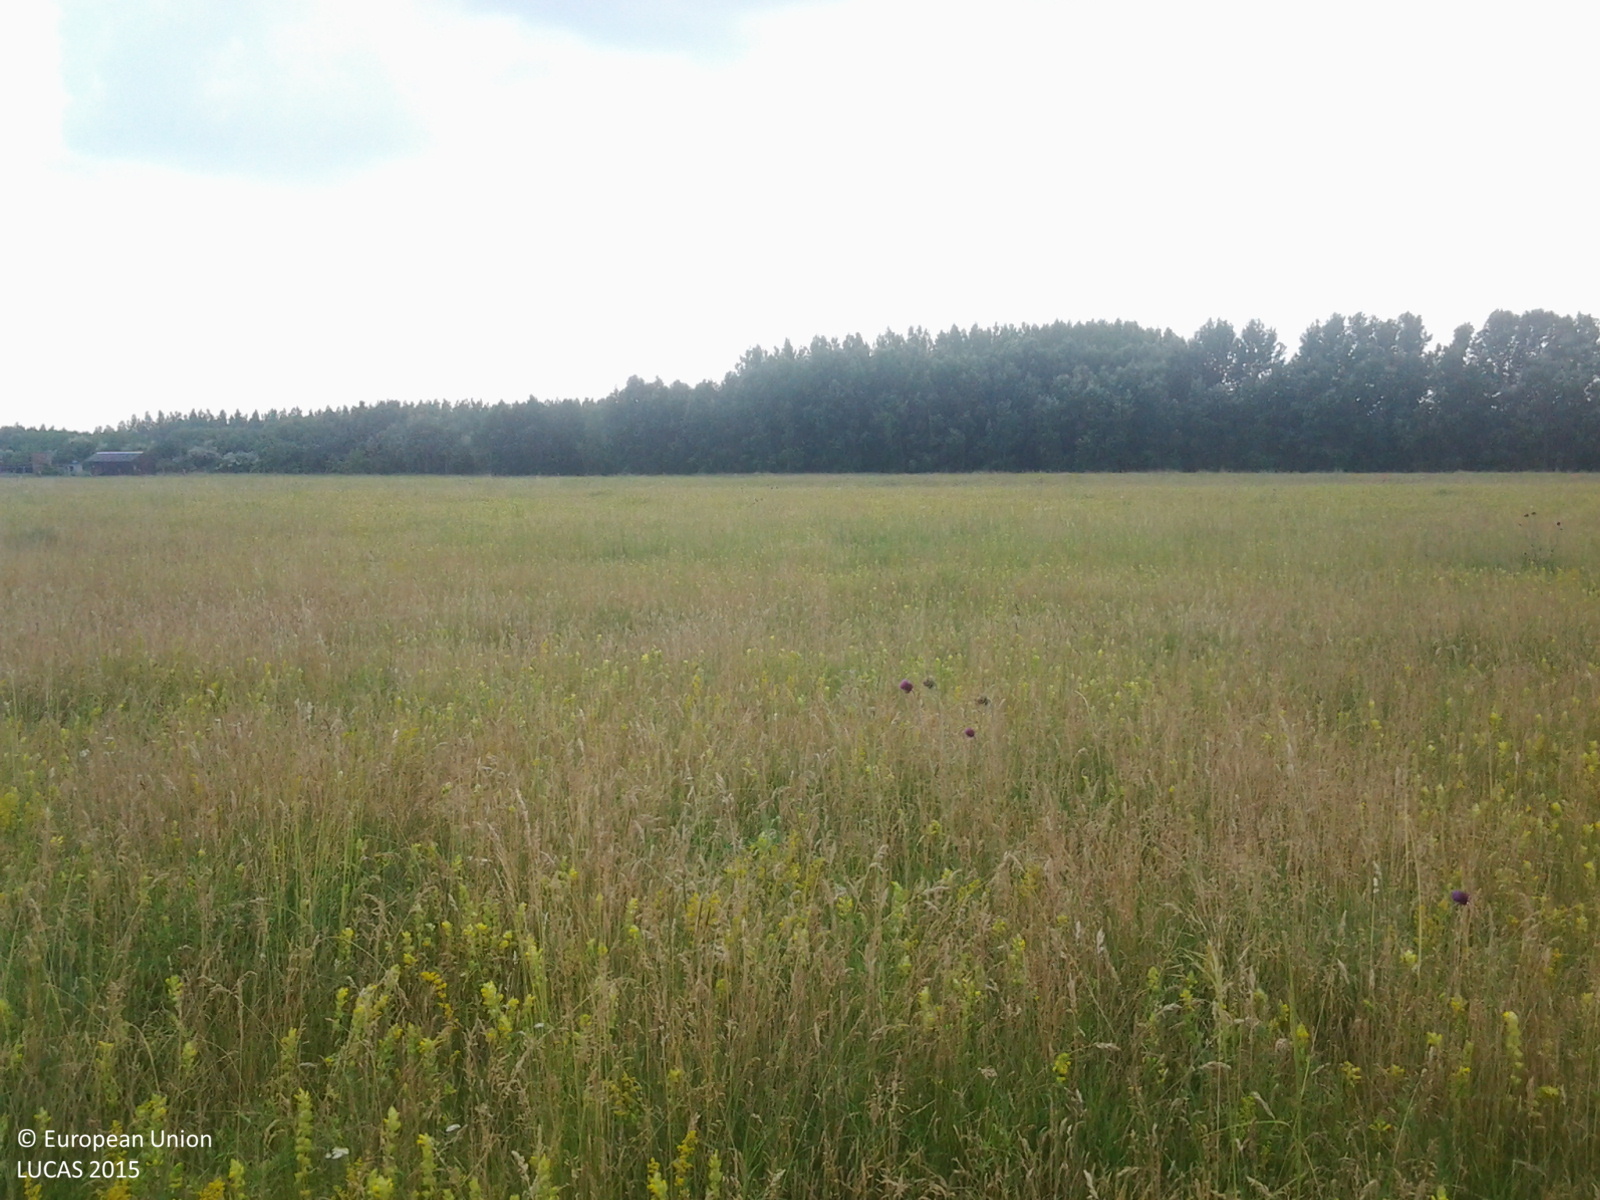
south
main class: Grassland
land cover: Grassland without tree/shrub cover
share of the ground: > 75 %
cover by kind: herbaceous plants 100 %
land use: Agriculture (excluding fallow land and kitchen gardens)
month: June
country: HU
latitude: 46.9177
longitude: 19.7779
